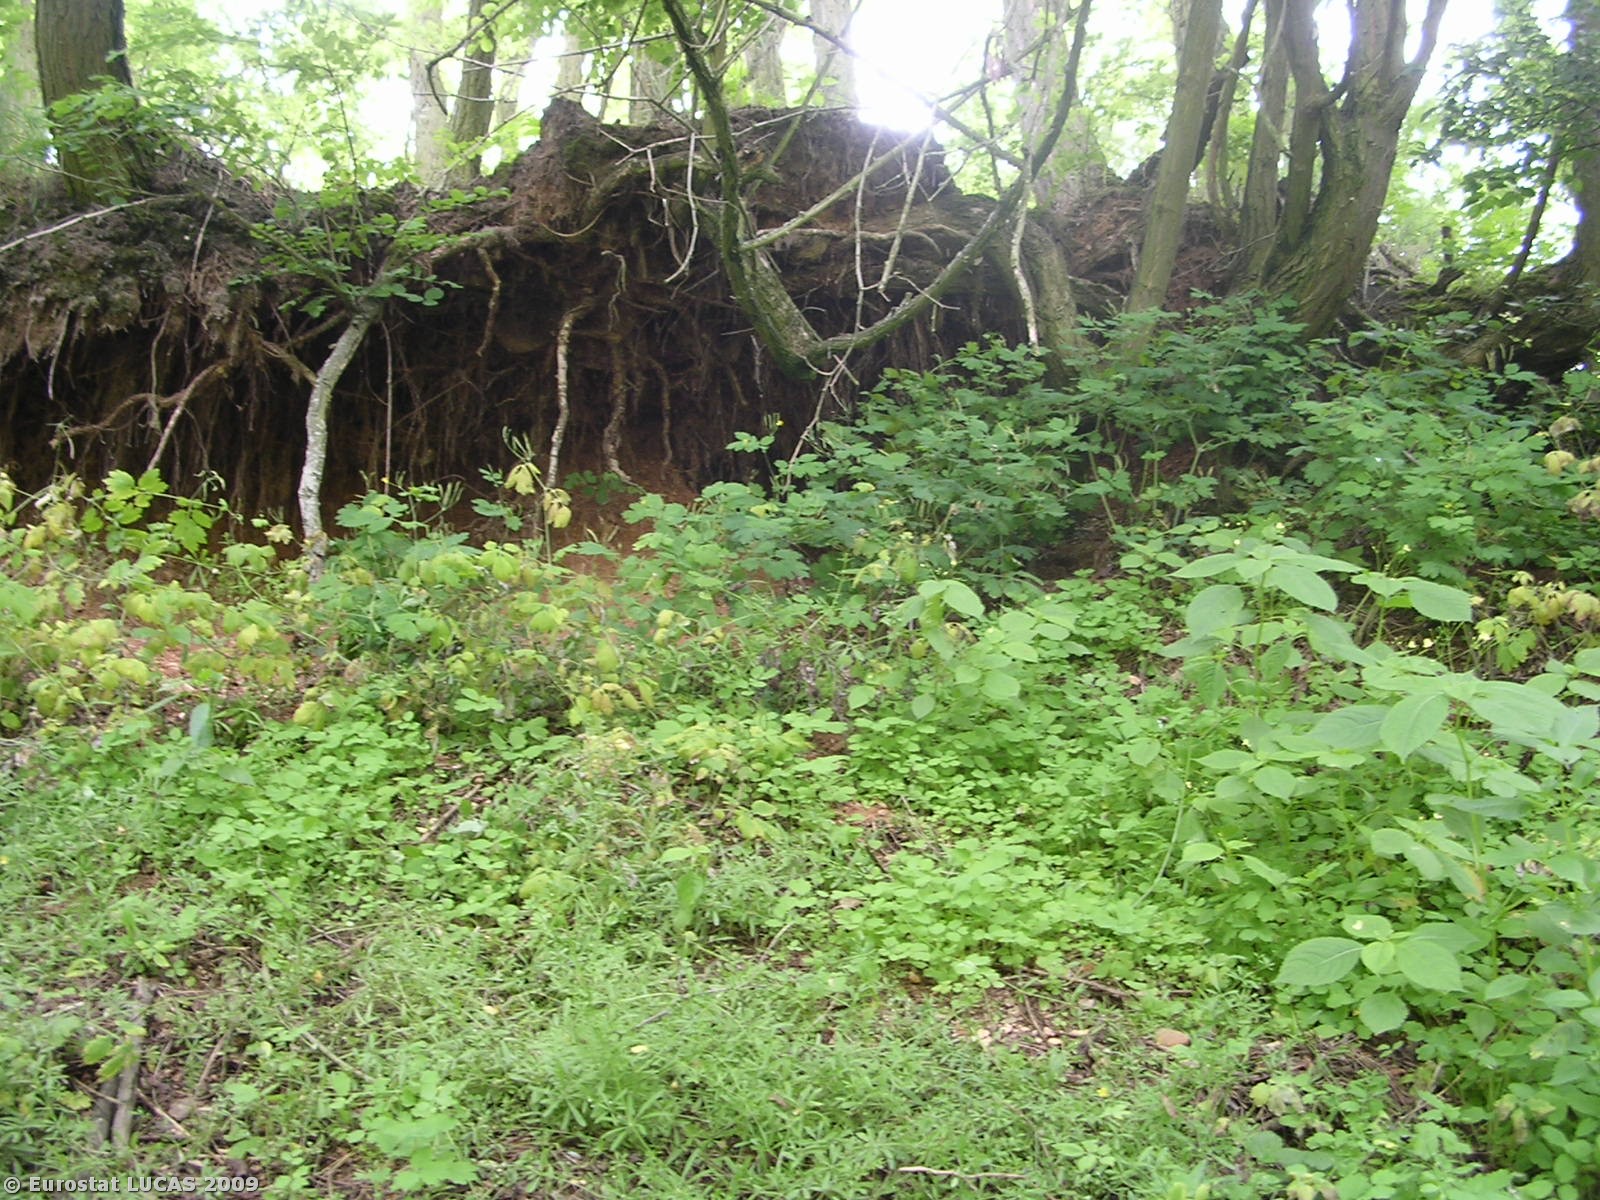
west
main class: Woodland
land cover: Broadleaved woodland
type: plantations and self-sown exotic forest
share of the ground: > 75 %
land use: Unused
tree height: > 5 m
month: June
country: CZ
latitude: 50.5091
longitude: 14.9522
